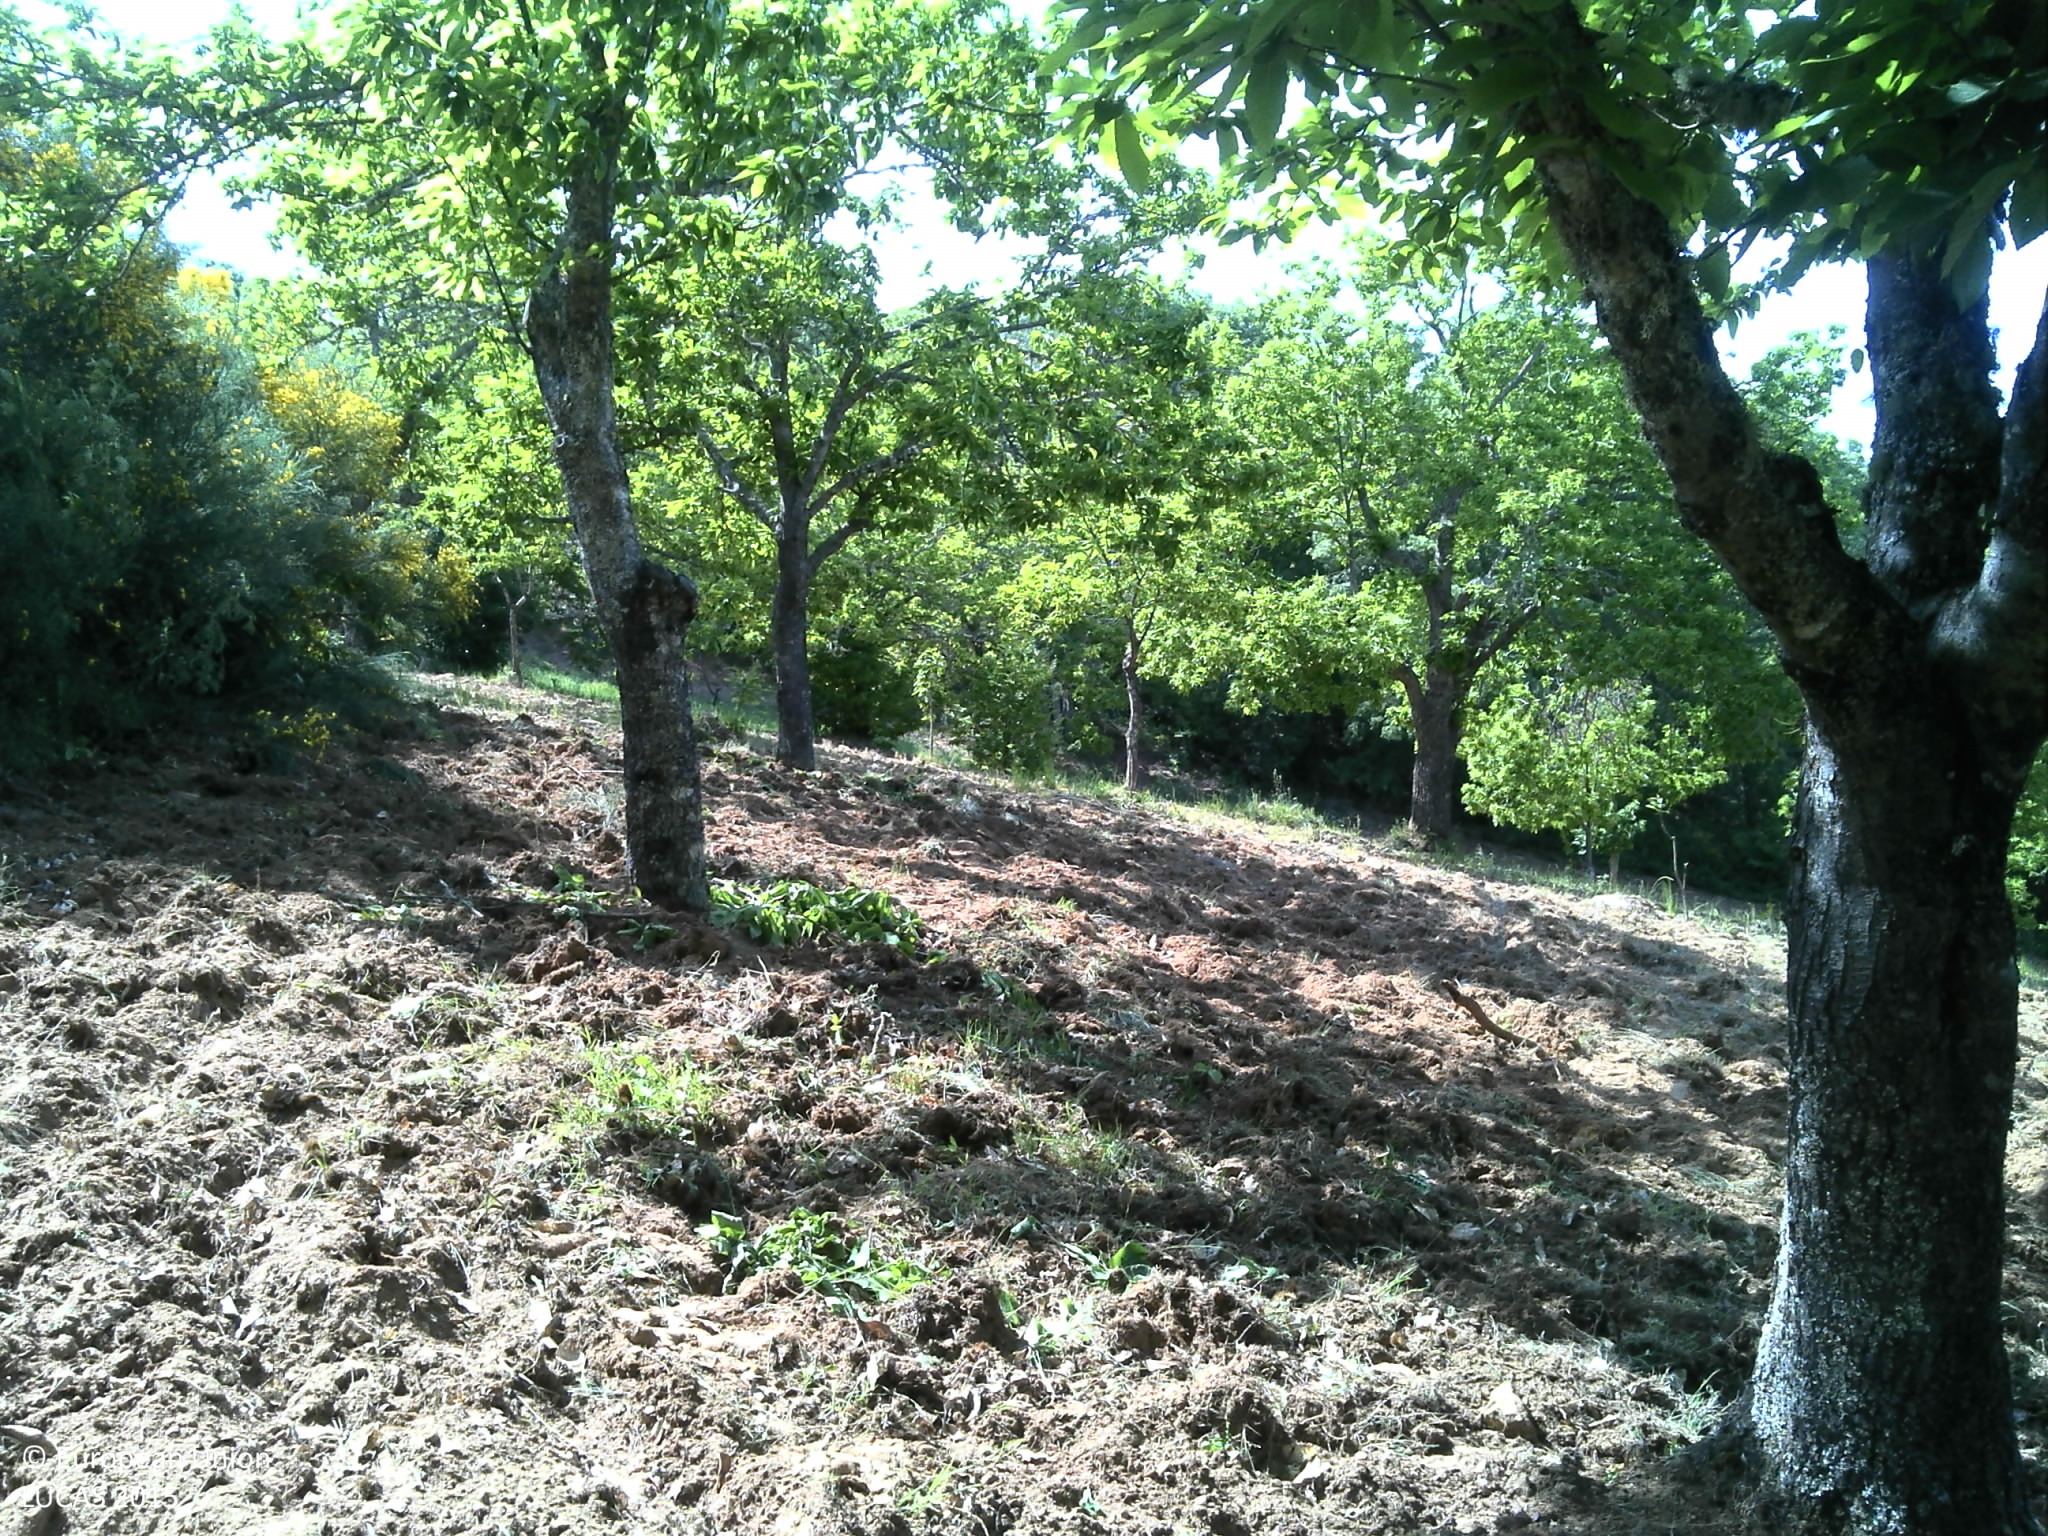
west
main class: Cropland
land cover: Nuts trees
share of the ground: 25 - 50 %
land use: Agriculture (excluding fallow land and kitchen gardens)
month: May
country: PT
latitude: 41.7145
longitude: -7.3502
